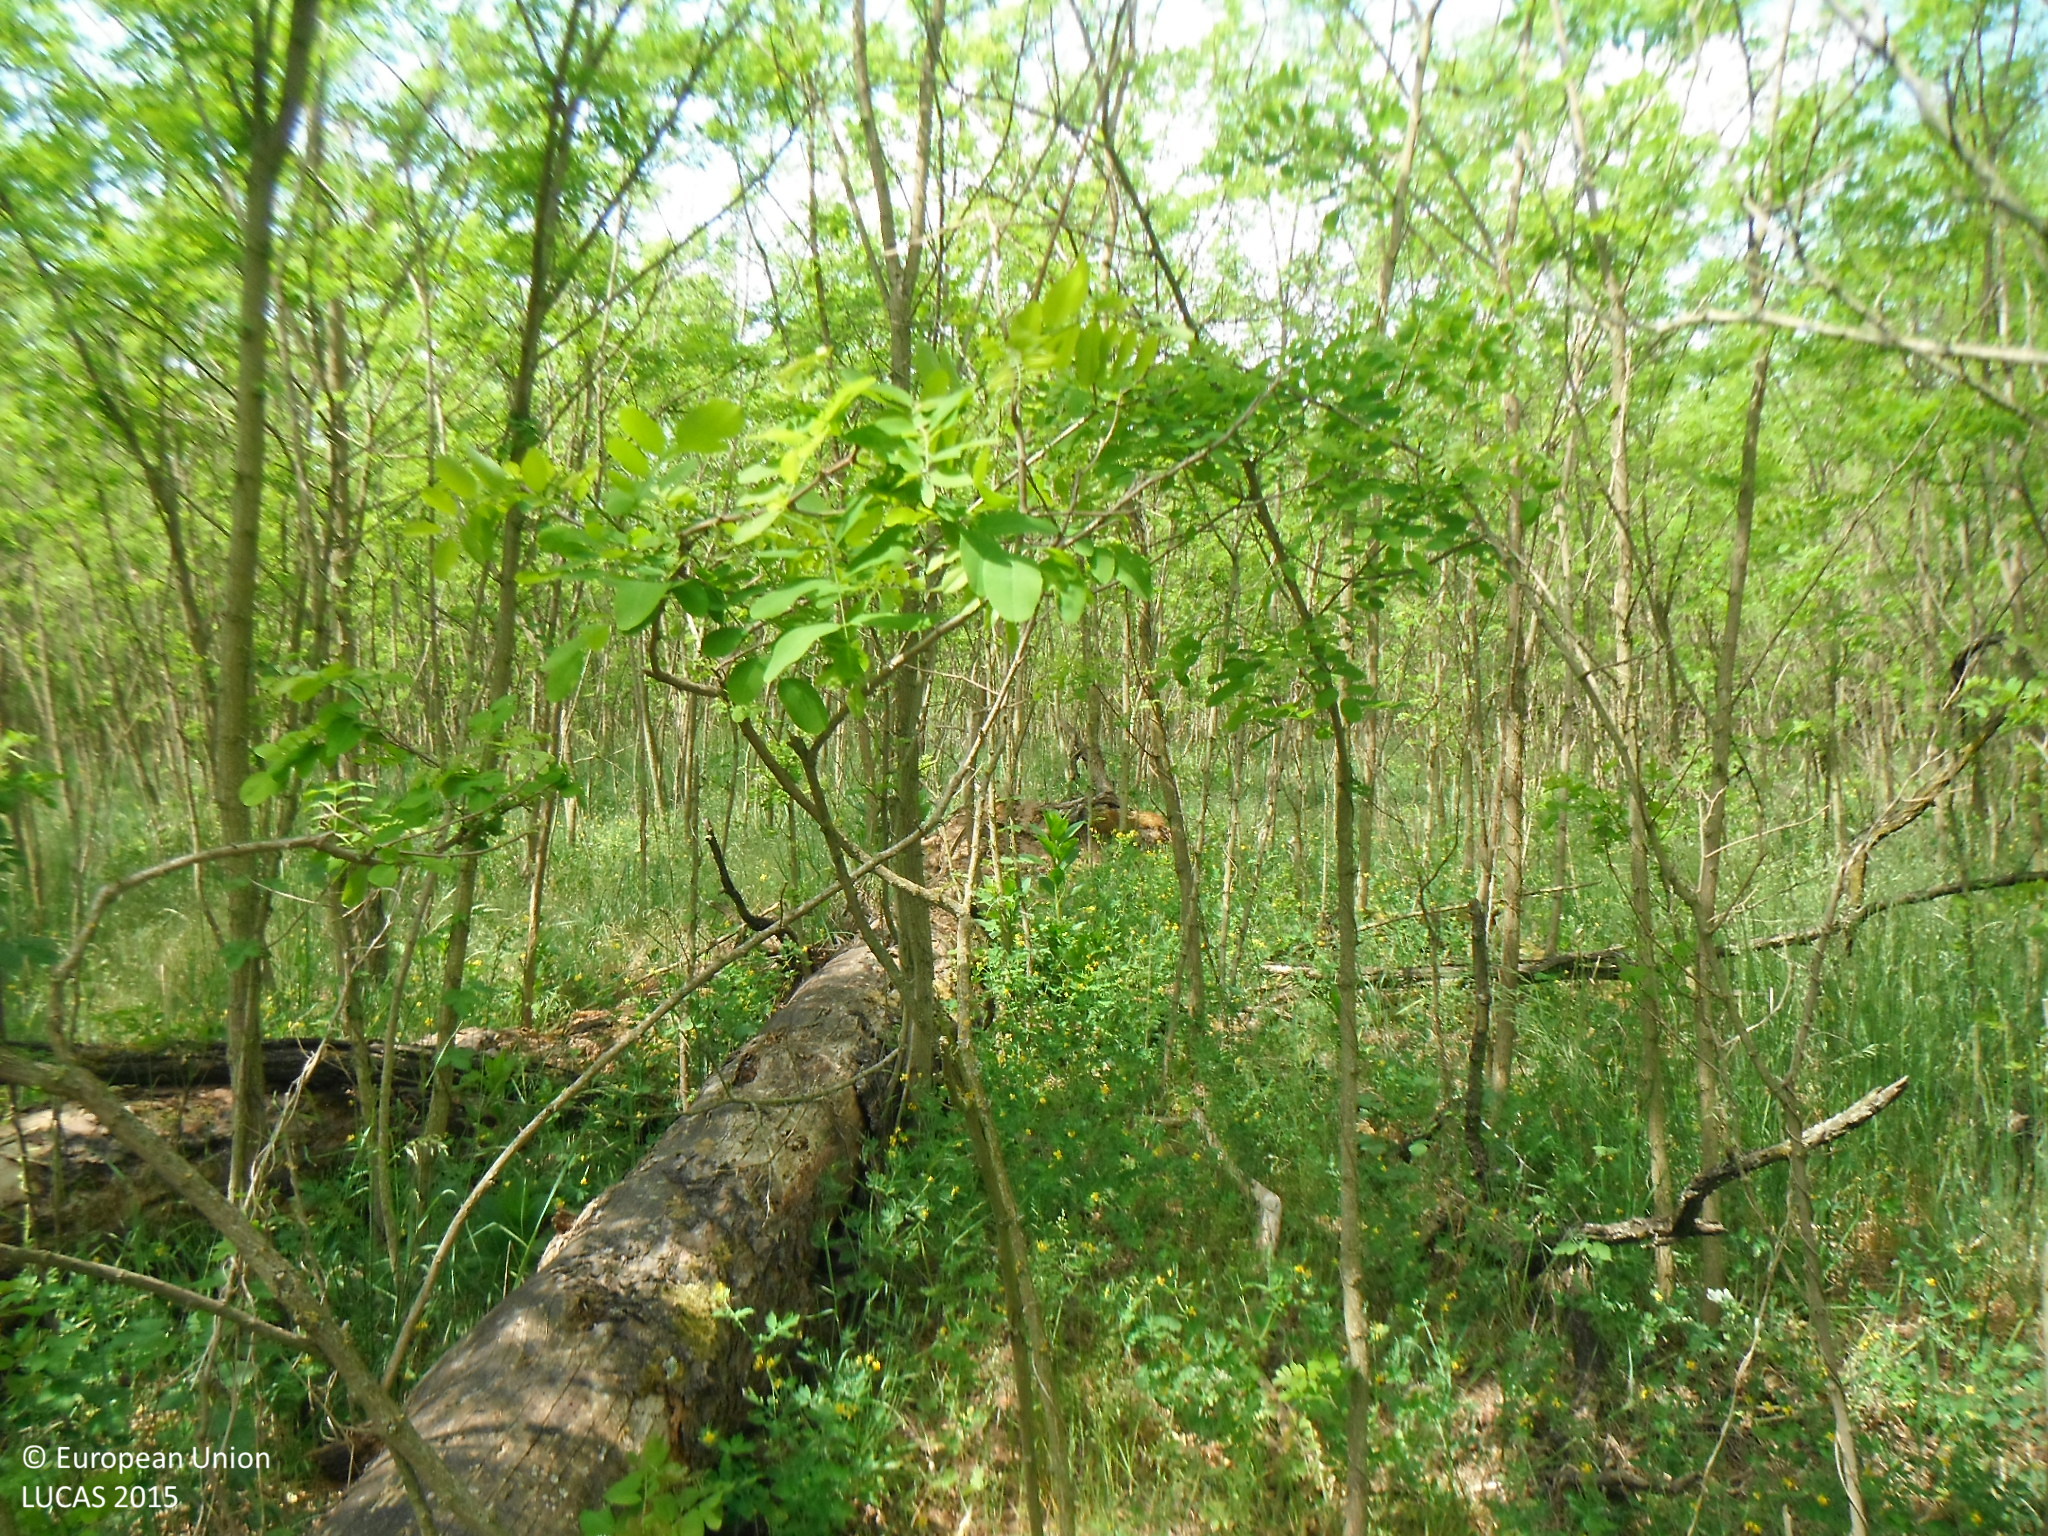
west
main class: Woodland
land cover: Broadleaved woodland
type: exotic forest
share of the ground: 50 - 75 %
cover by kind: broadleaved forest trees 60 %, shrubs 20 %, herbaceous plants 20 %
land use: Forestry
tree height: > 5 m
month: May
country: SK
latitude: 48.4218
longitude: 16.9127
